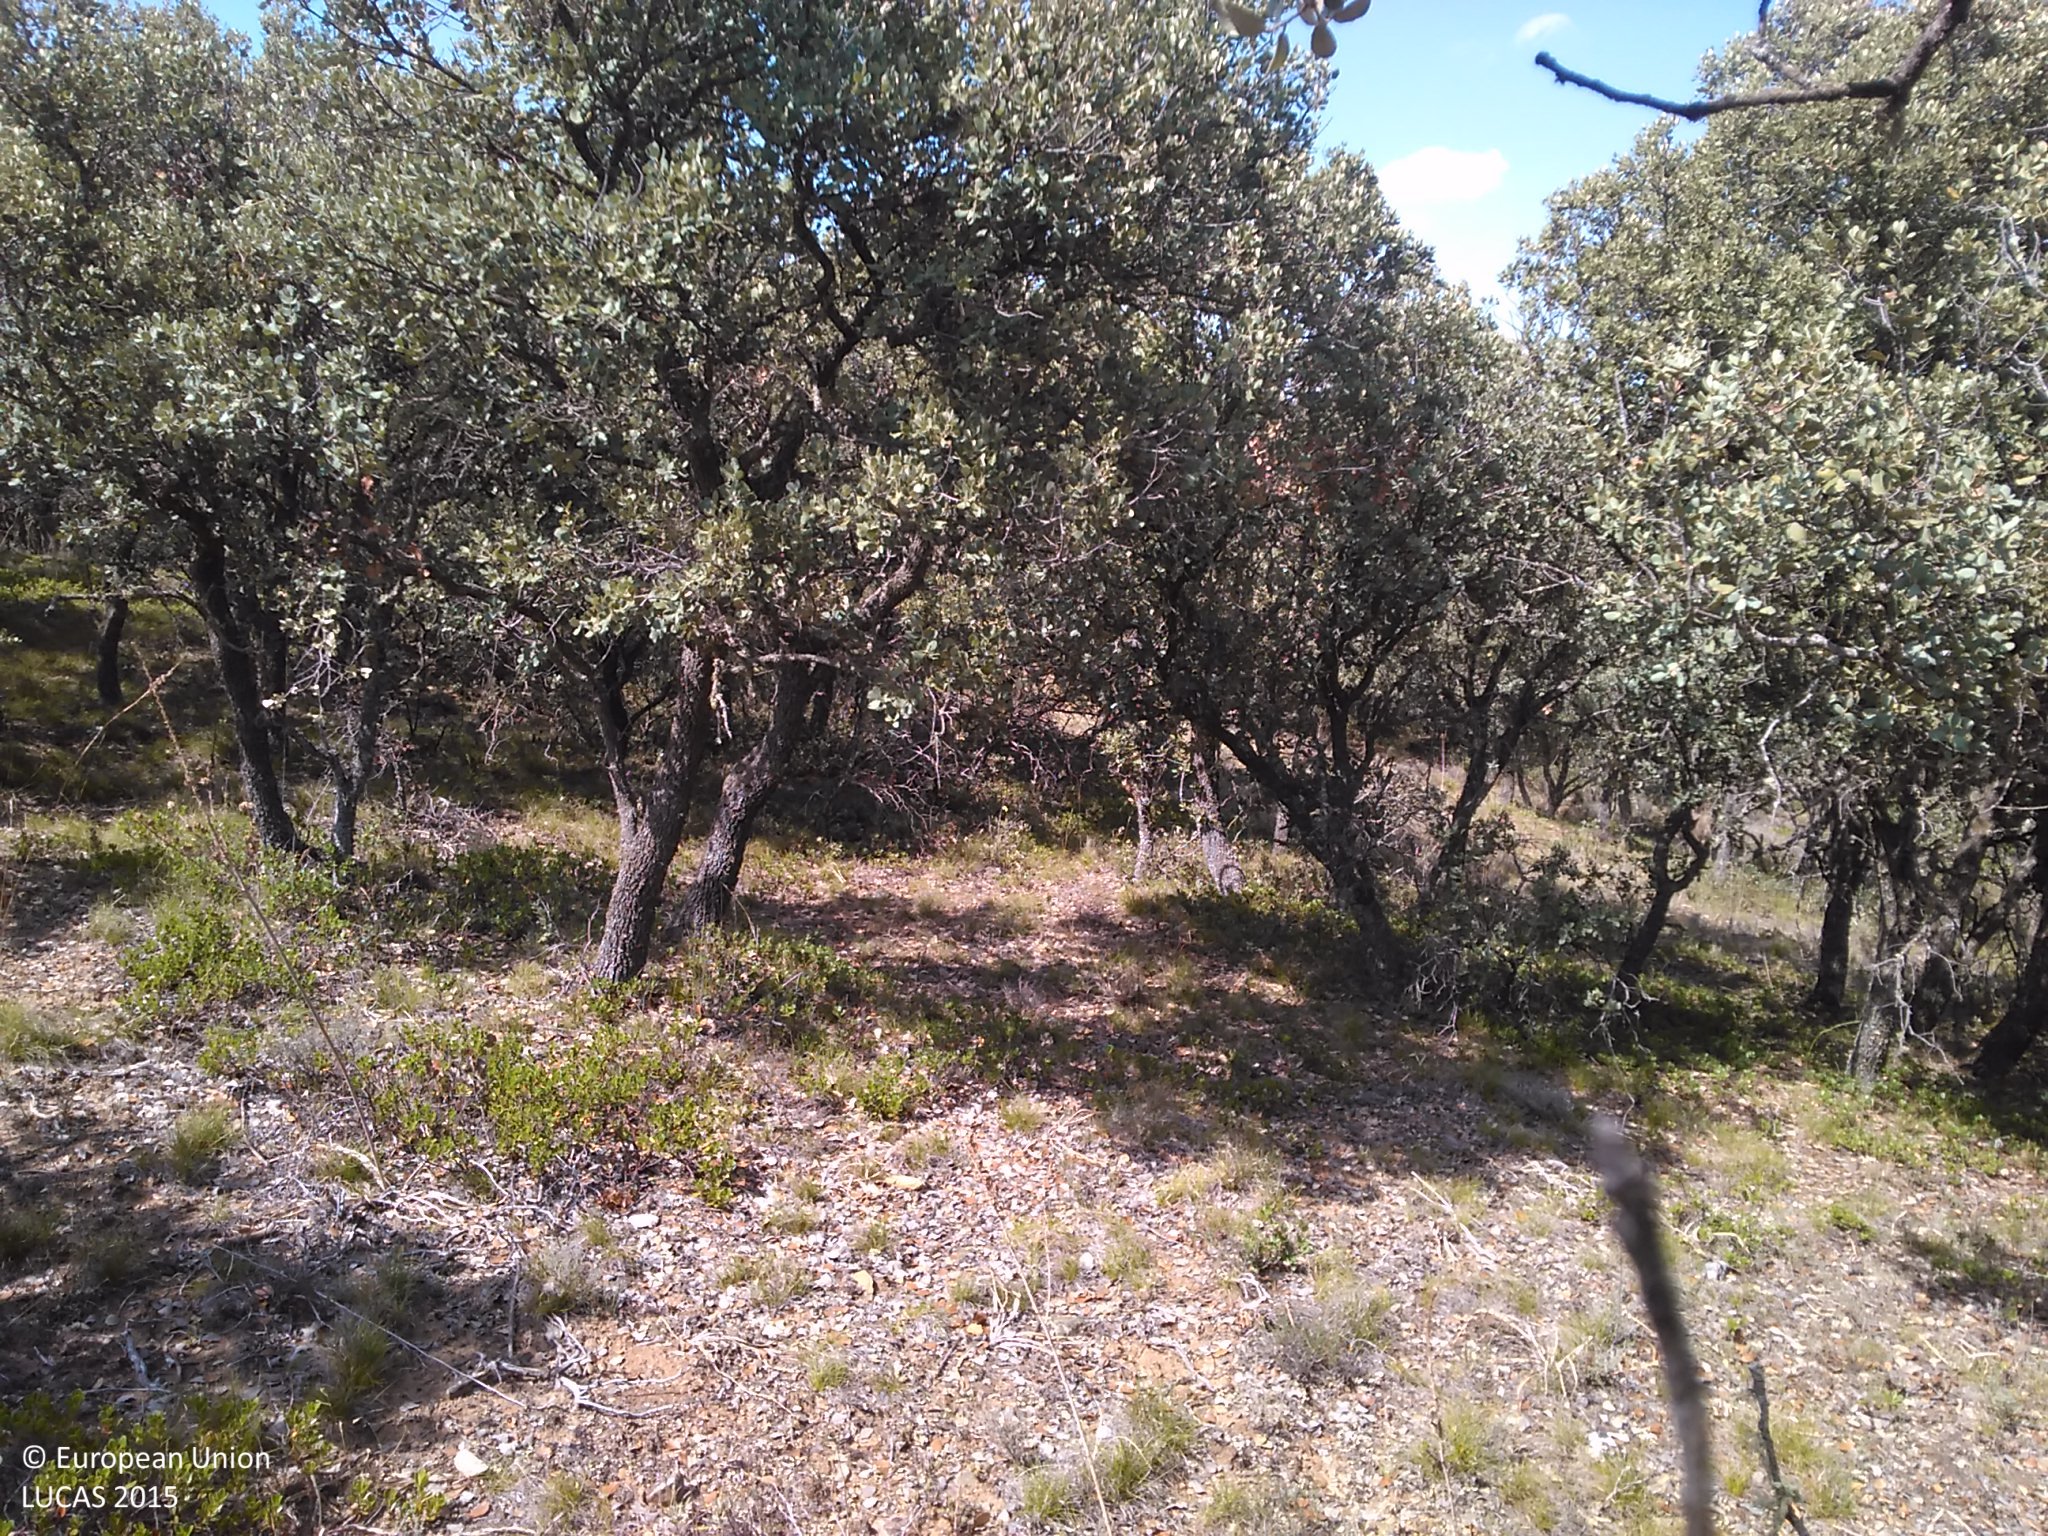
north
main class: Woodland
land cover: Broadleaved woodland
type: thermophilous deciduous forest
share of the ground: 50 - 75 %
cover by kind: broadleaved forest trees 60 %, unconsolidated bare surface 15 %, shrubs 10 %, herbaceous plants 10 %, lichens and mosses 5 %
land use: Semi-natural and natural areas not in use
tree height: < 5 m
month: July
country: ES
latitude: 41.5307
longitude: -2.1975
